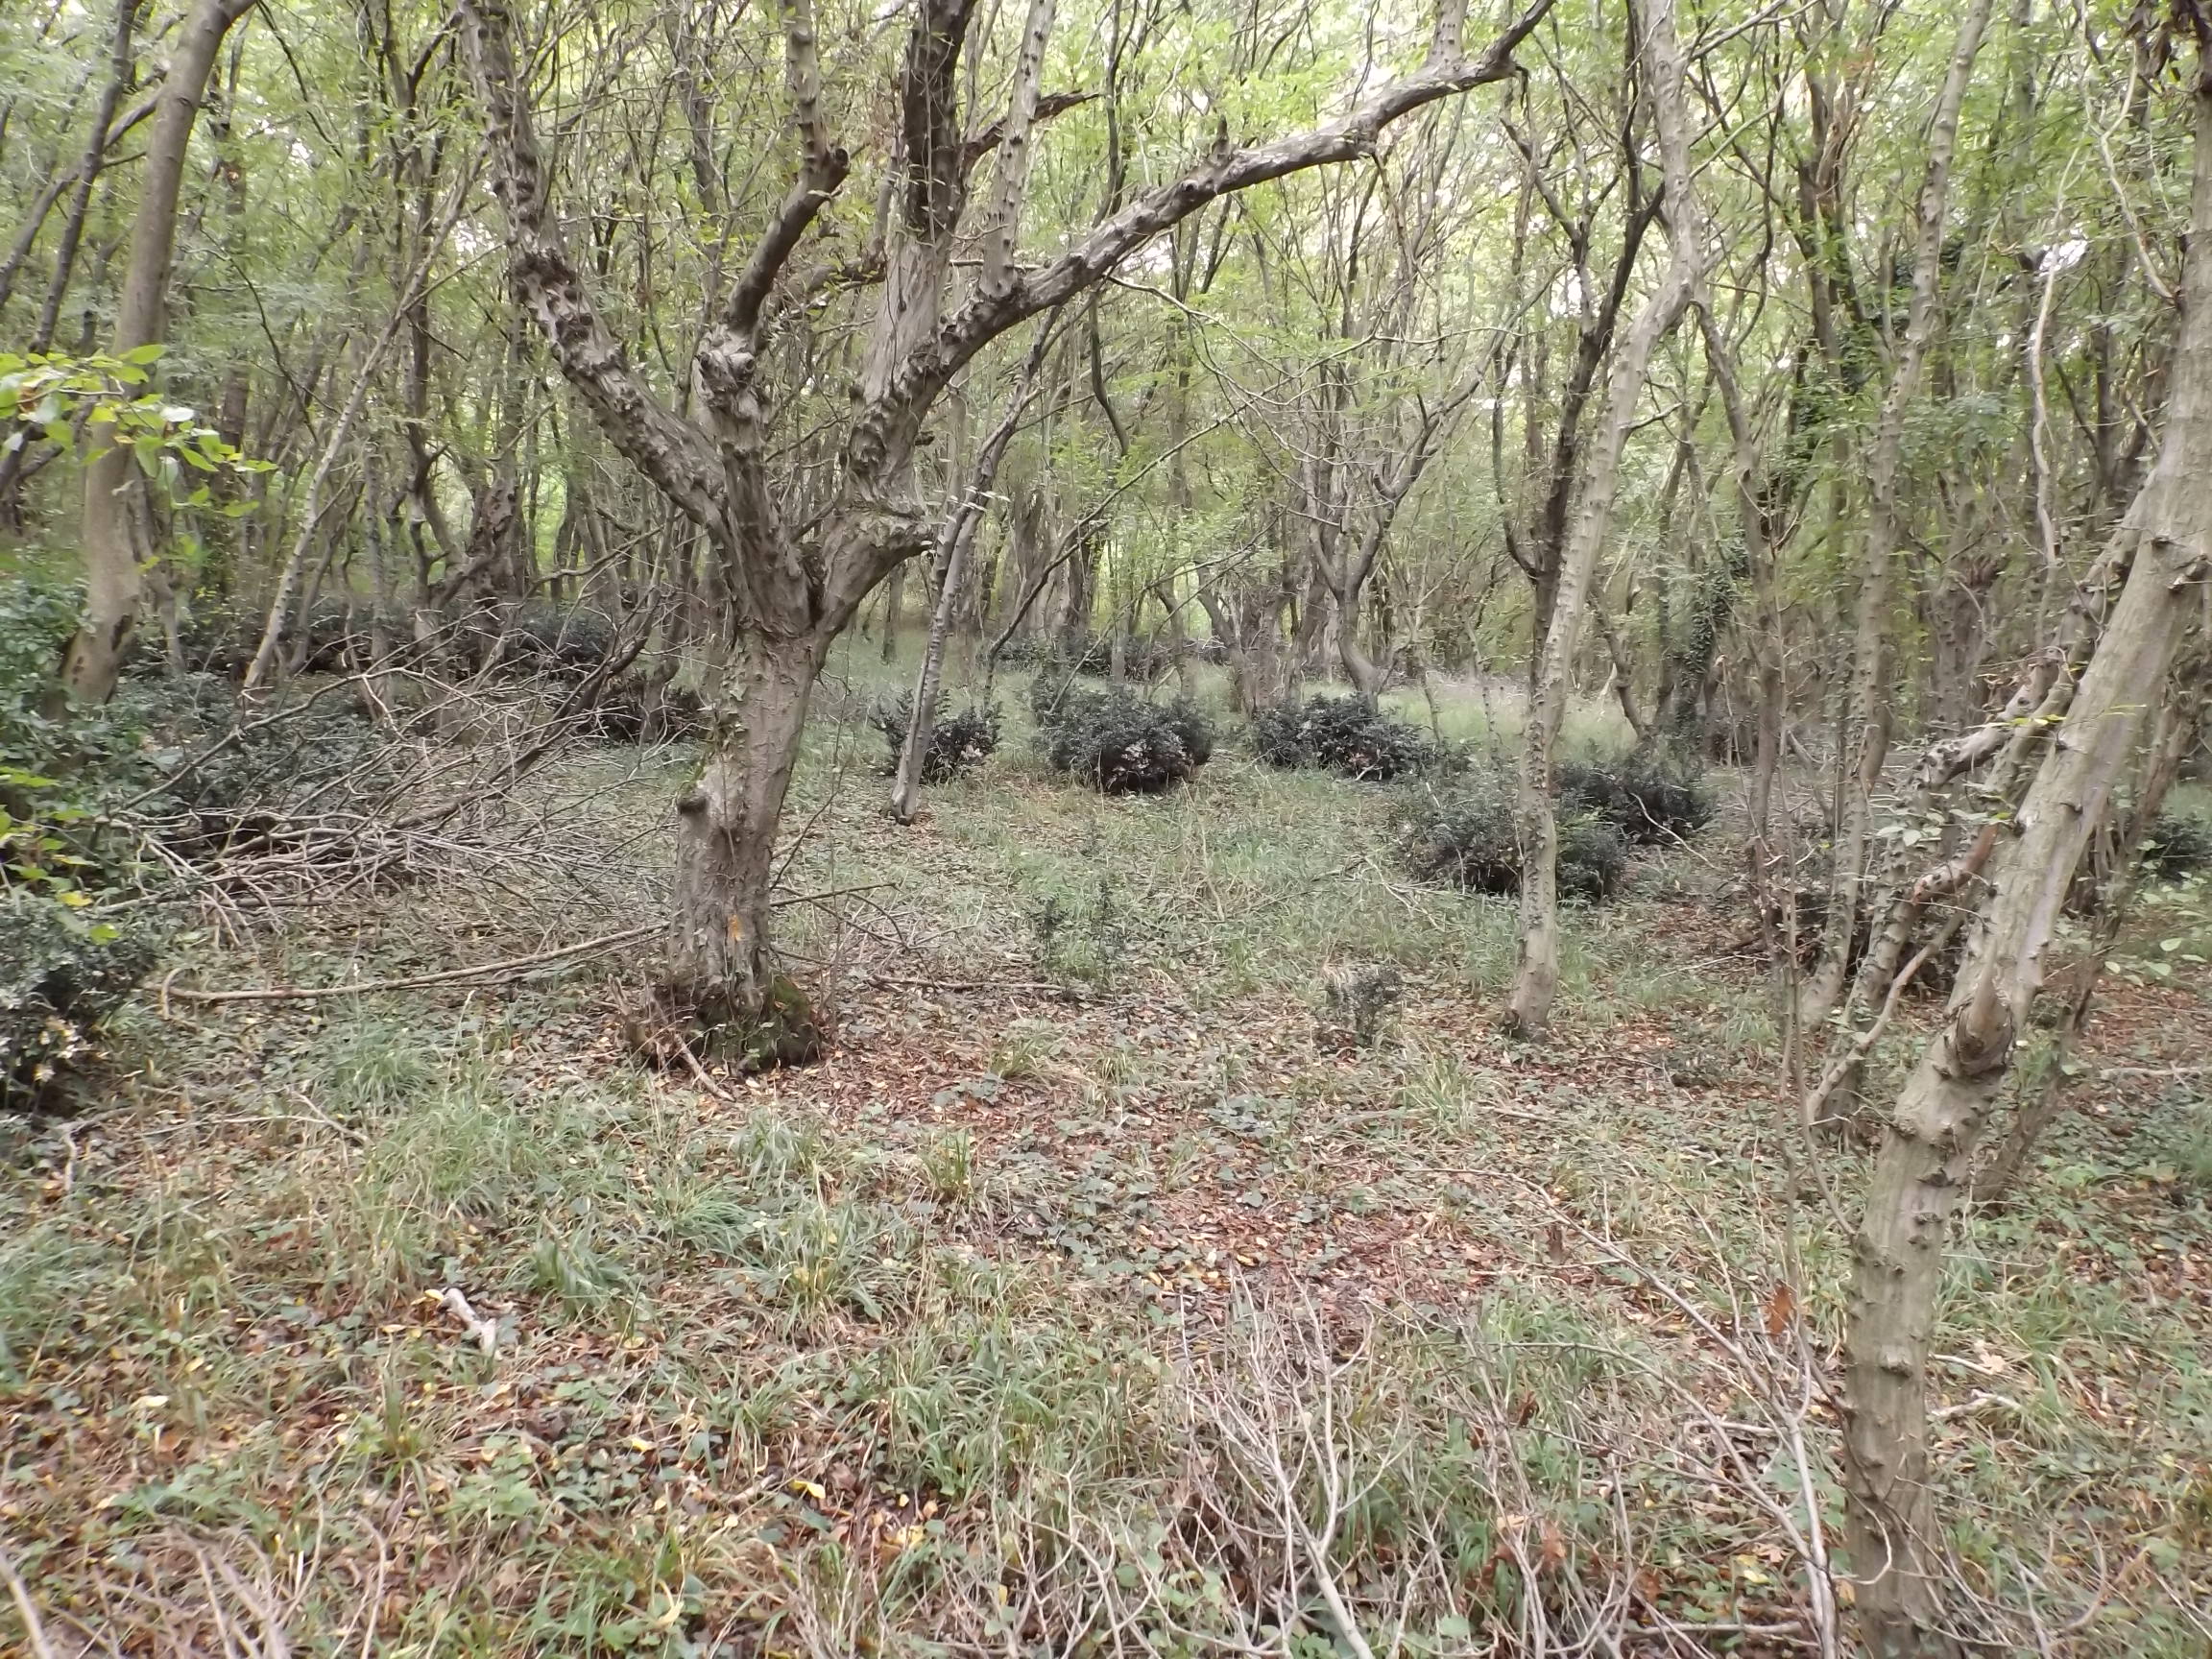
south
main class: Woodland
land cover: Broadleaved woodland
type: beech forest
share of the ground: > 75 %
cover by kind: broadleaved forest trees 100 %
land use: Forestry
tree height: > 5 m
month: September
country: BG
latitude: 43.1405
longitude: 27.6254
